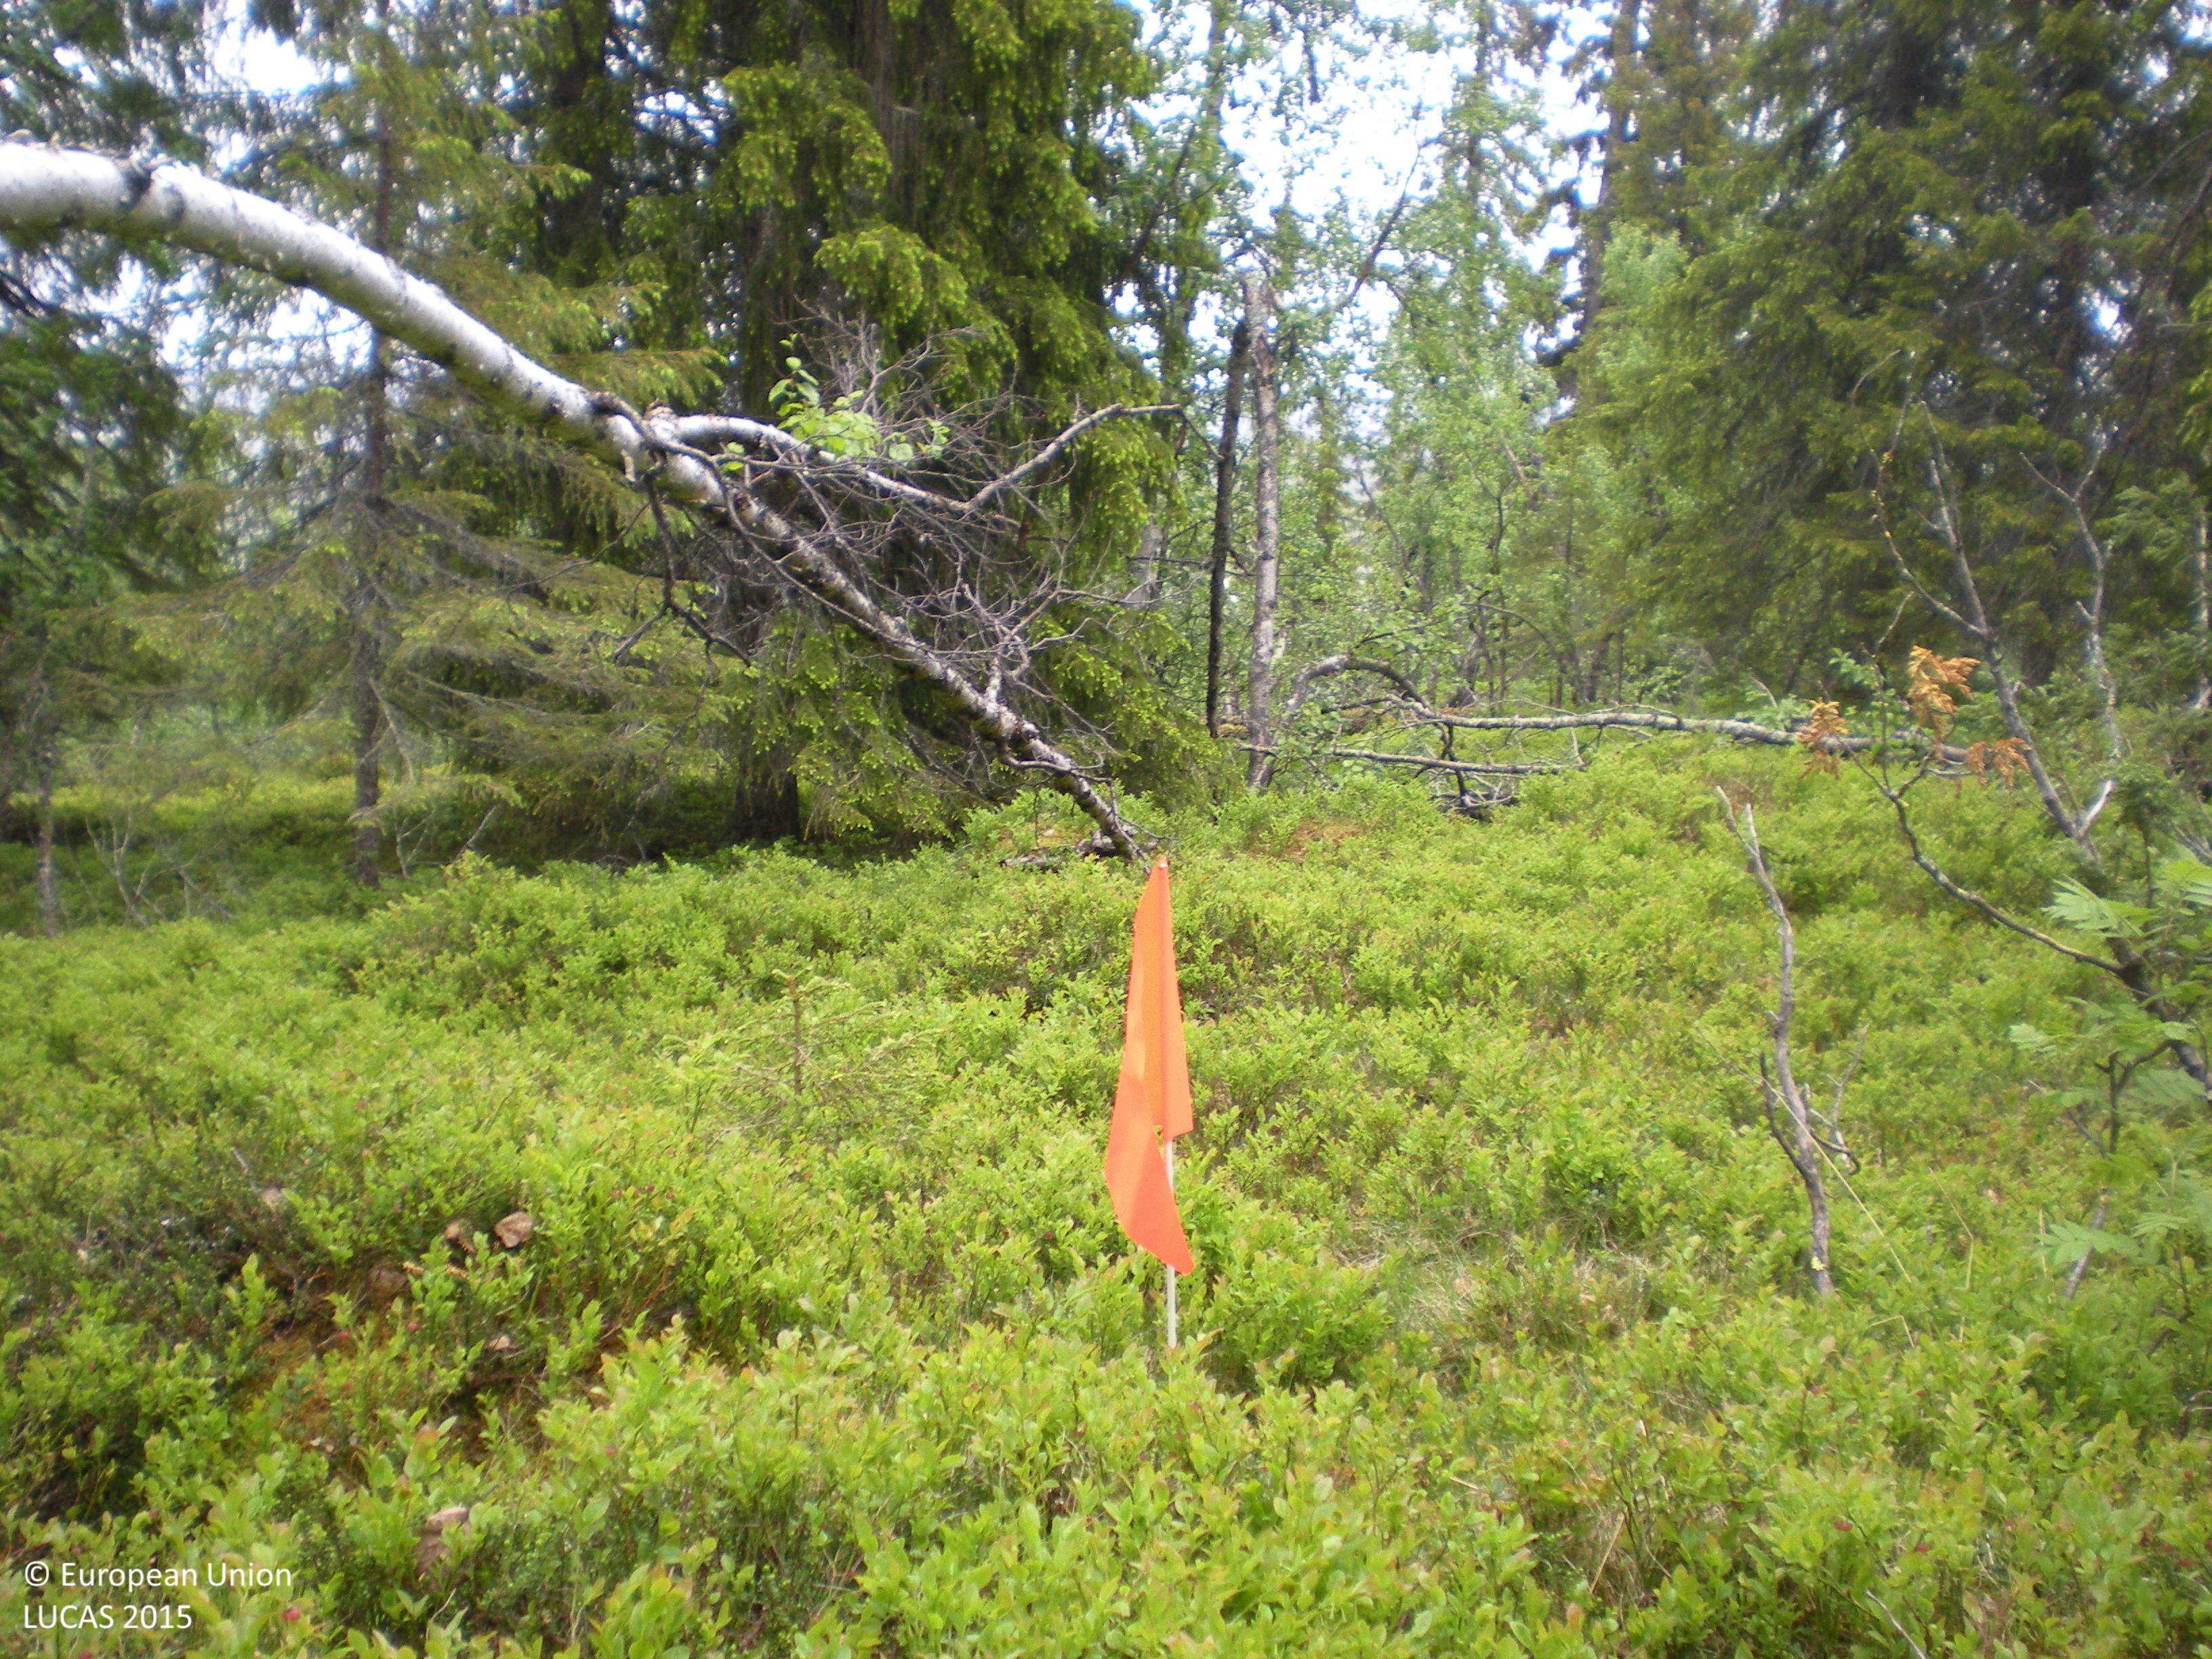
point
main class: Woodland
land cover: Spruce dominated mixed woodland
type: boreal forest
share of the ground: 50 - 75 %
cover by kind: coniferous forest trees 55 %, broadleaved forest trees 20 %, shrubs 20 %, lichens and mosses 5 %
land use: Semi-natural and natural areas not in use
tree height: > 5 m
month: July
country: SE
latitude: 66.1214
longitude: 17.2390
